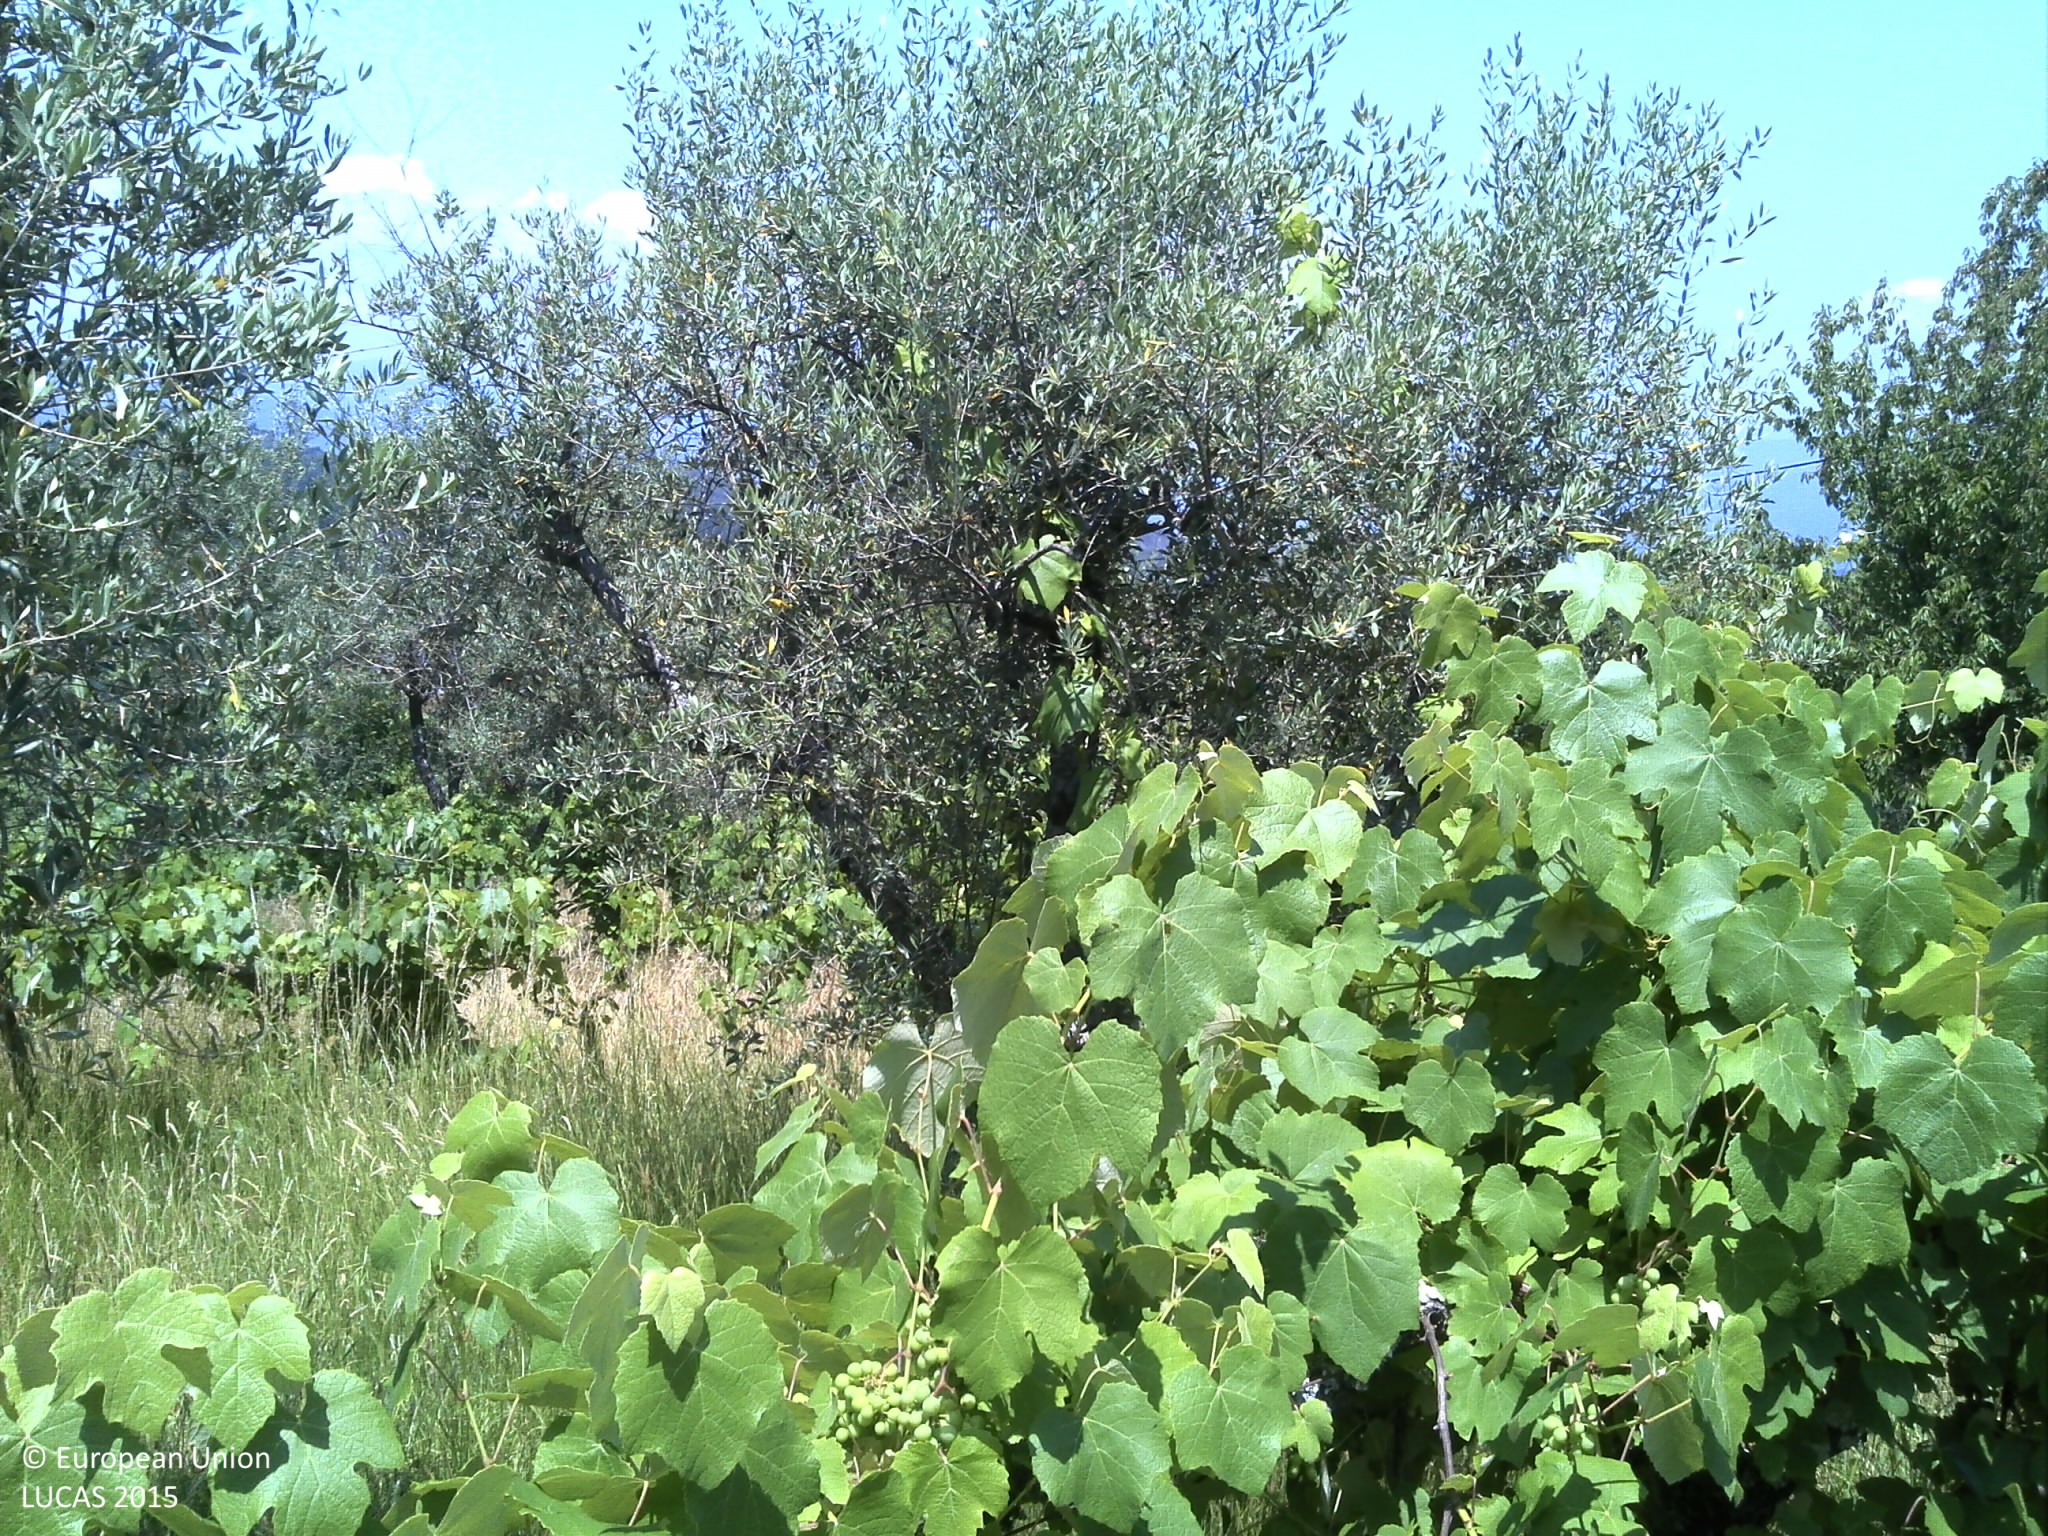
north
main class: Cropland
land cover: Vineyards
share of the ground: 25 - 50 %
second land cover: Grassland without tree/shrub cover
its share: 25 - 50 %
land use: Agriculture (excluding fallow land and kitchen gardens)
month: June
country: PT
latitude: 40.7144
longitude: -8.2825
